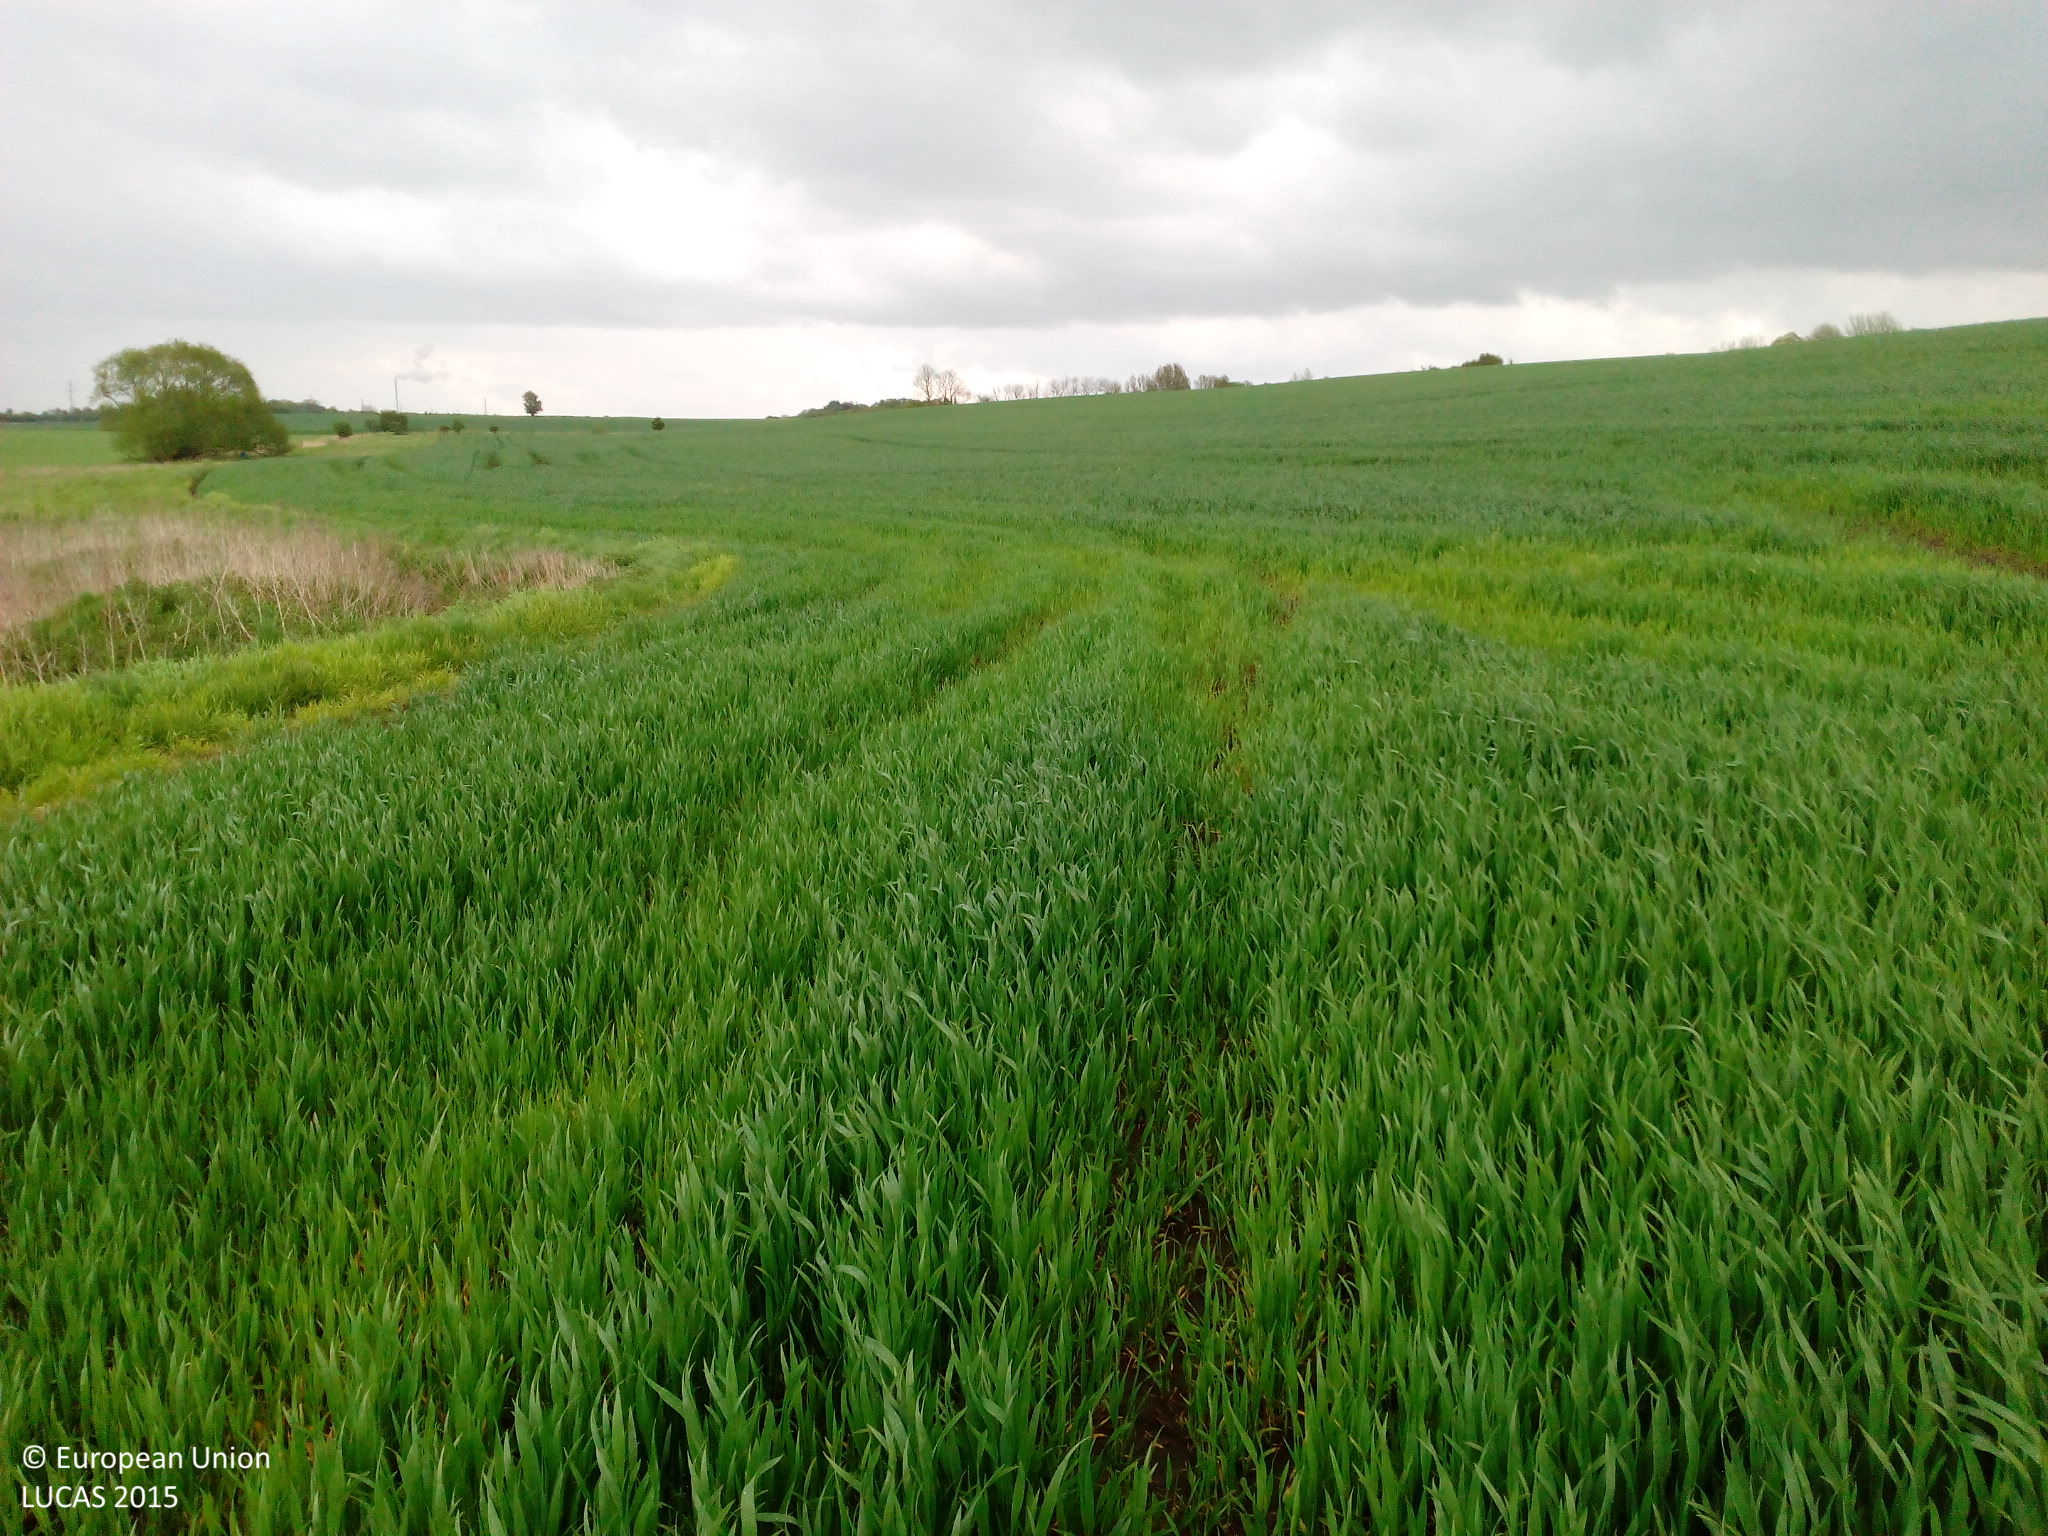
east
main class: Cropland
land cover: Common wheat
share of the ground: > 75 %
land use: Agriculture (excluding fallow land and kitchen gardens)
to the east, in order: Common wheat
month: May
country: DK
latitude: 55.6150
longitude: 11.9829
